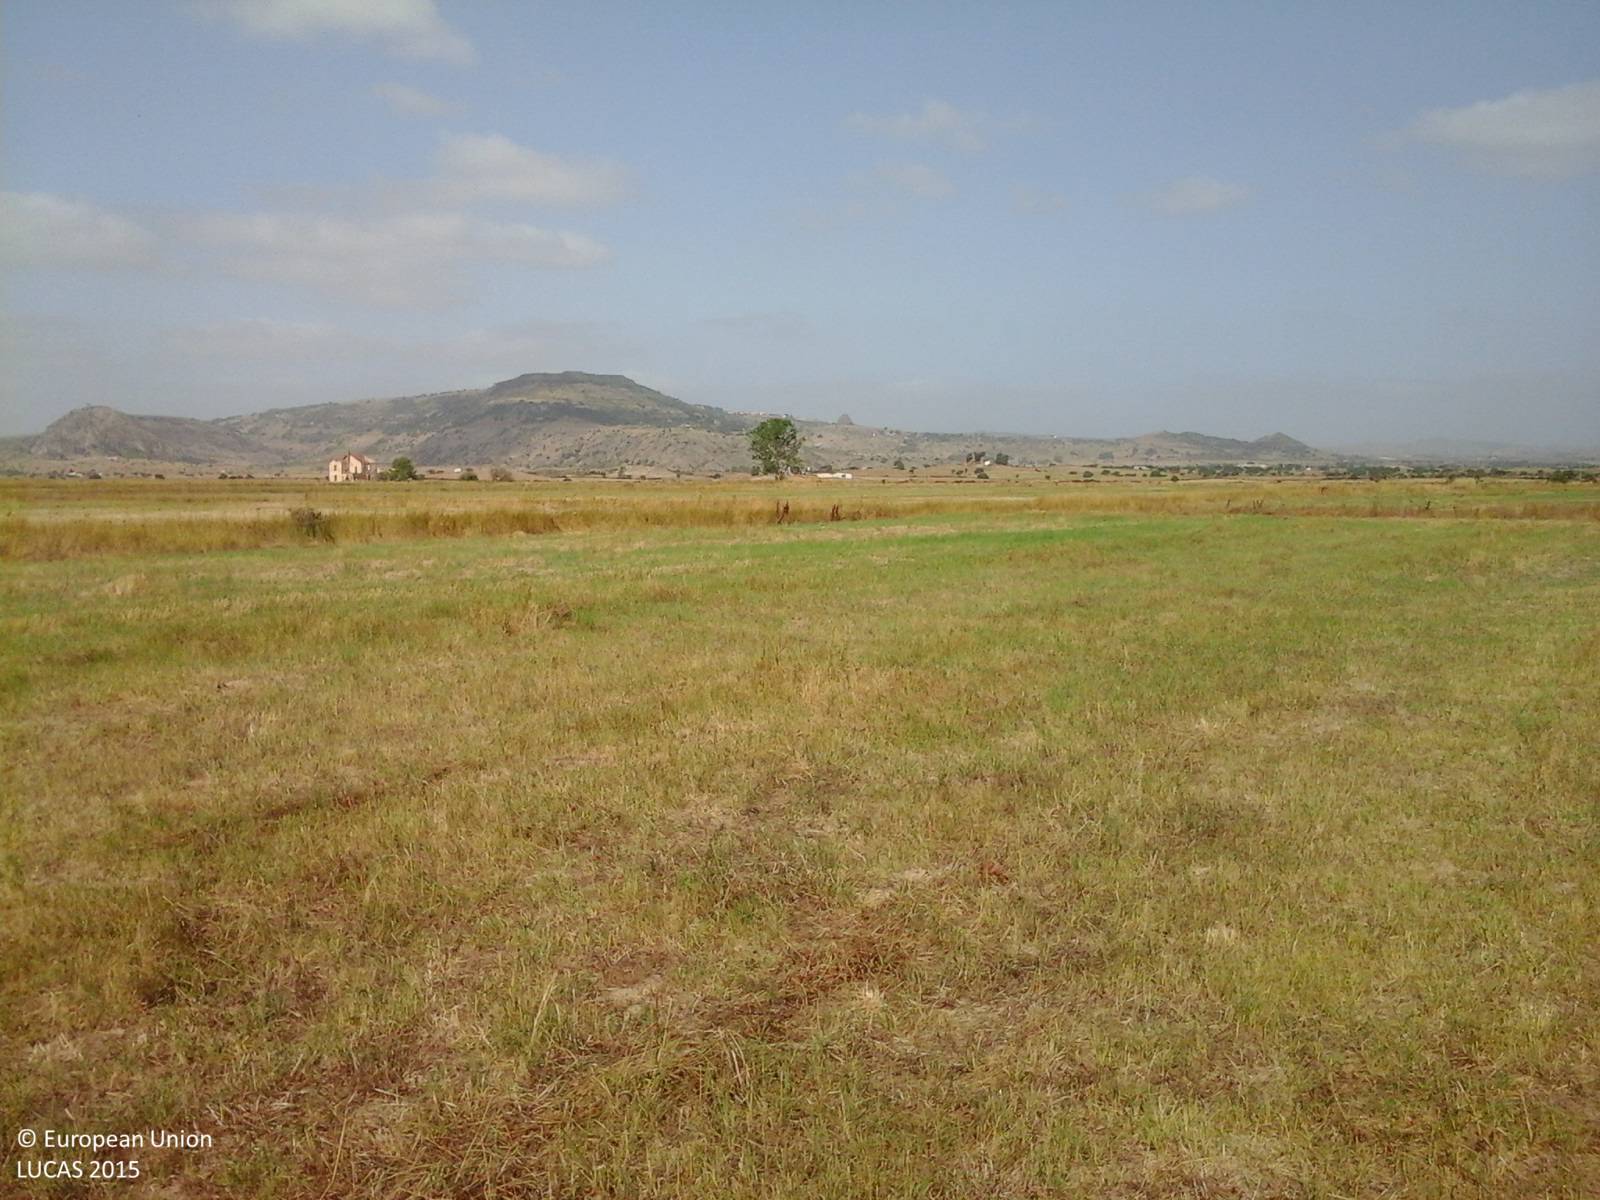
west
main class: Grassland
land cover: Grassland without tree/shrub cover
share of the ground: < 10 %
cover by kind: herbaceous plants 100 %
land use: Agriculture (excluding fallow land and kitchen gardens)
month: July
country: IT
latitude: 40.4593
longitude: 8.8149
